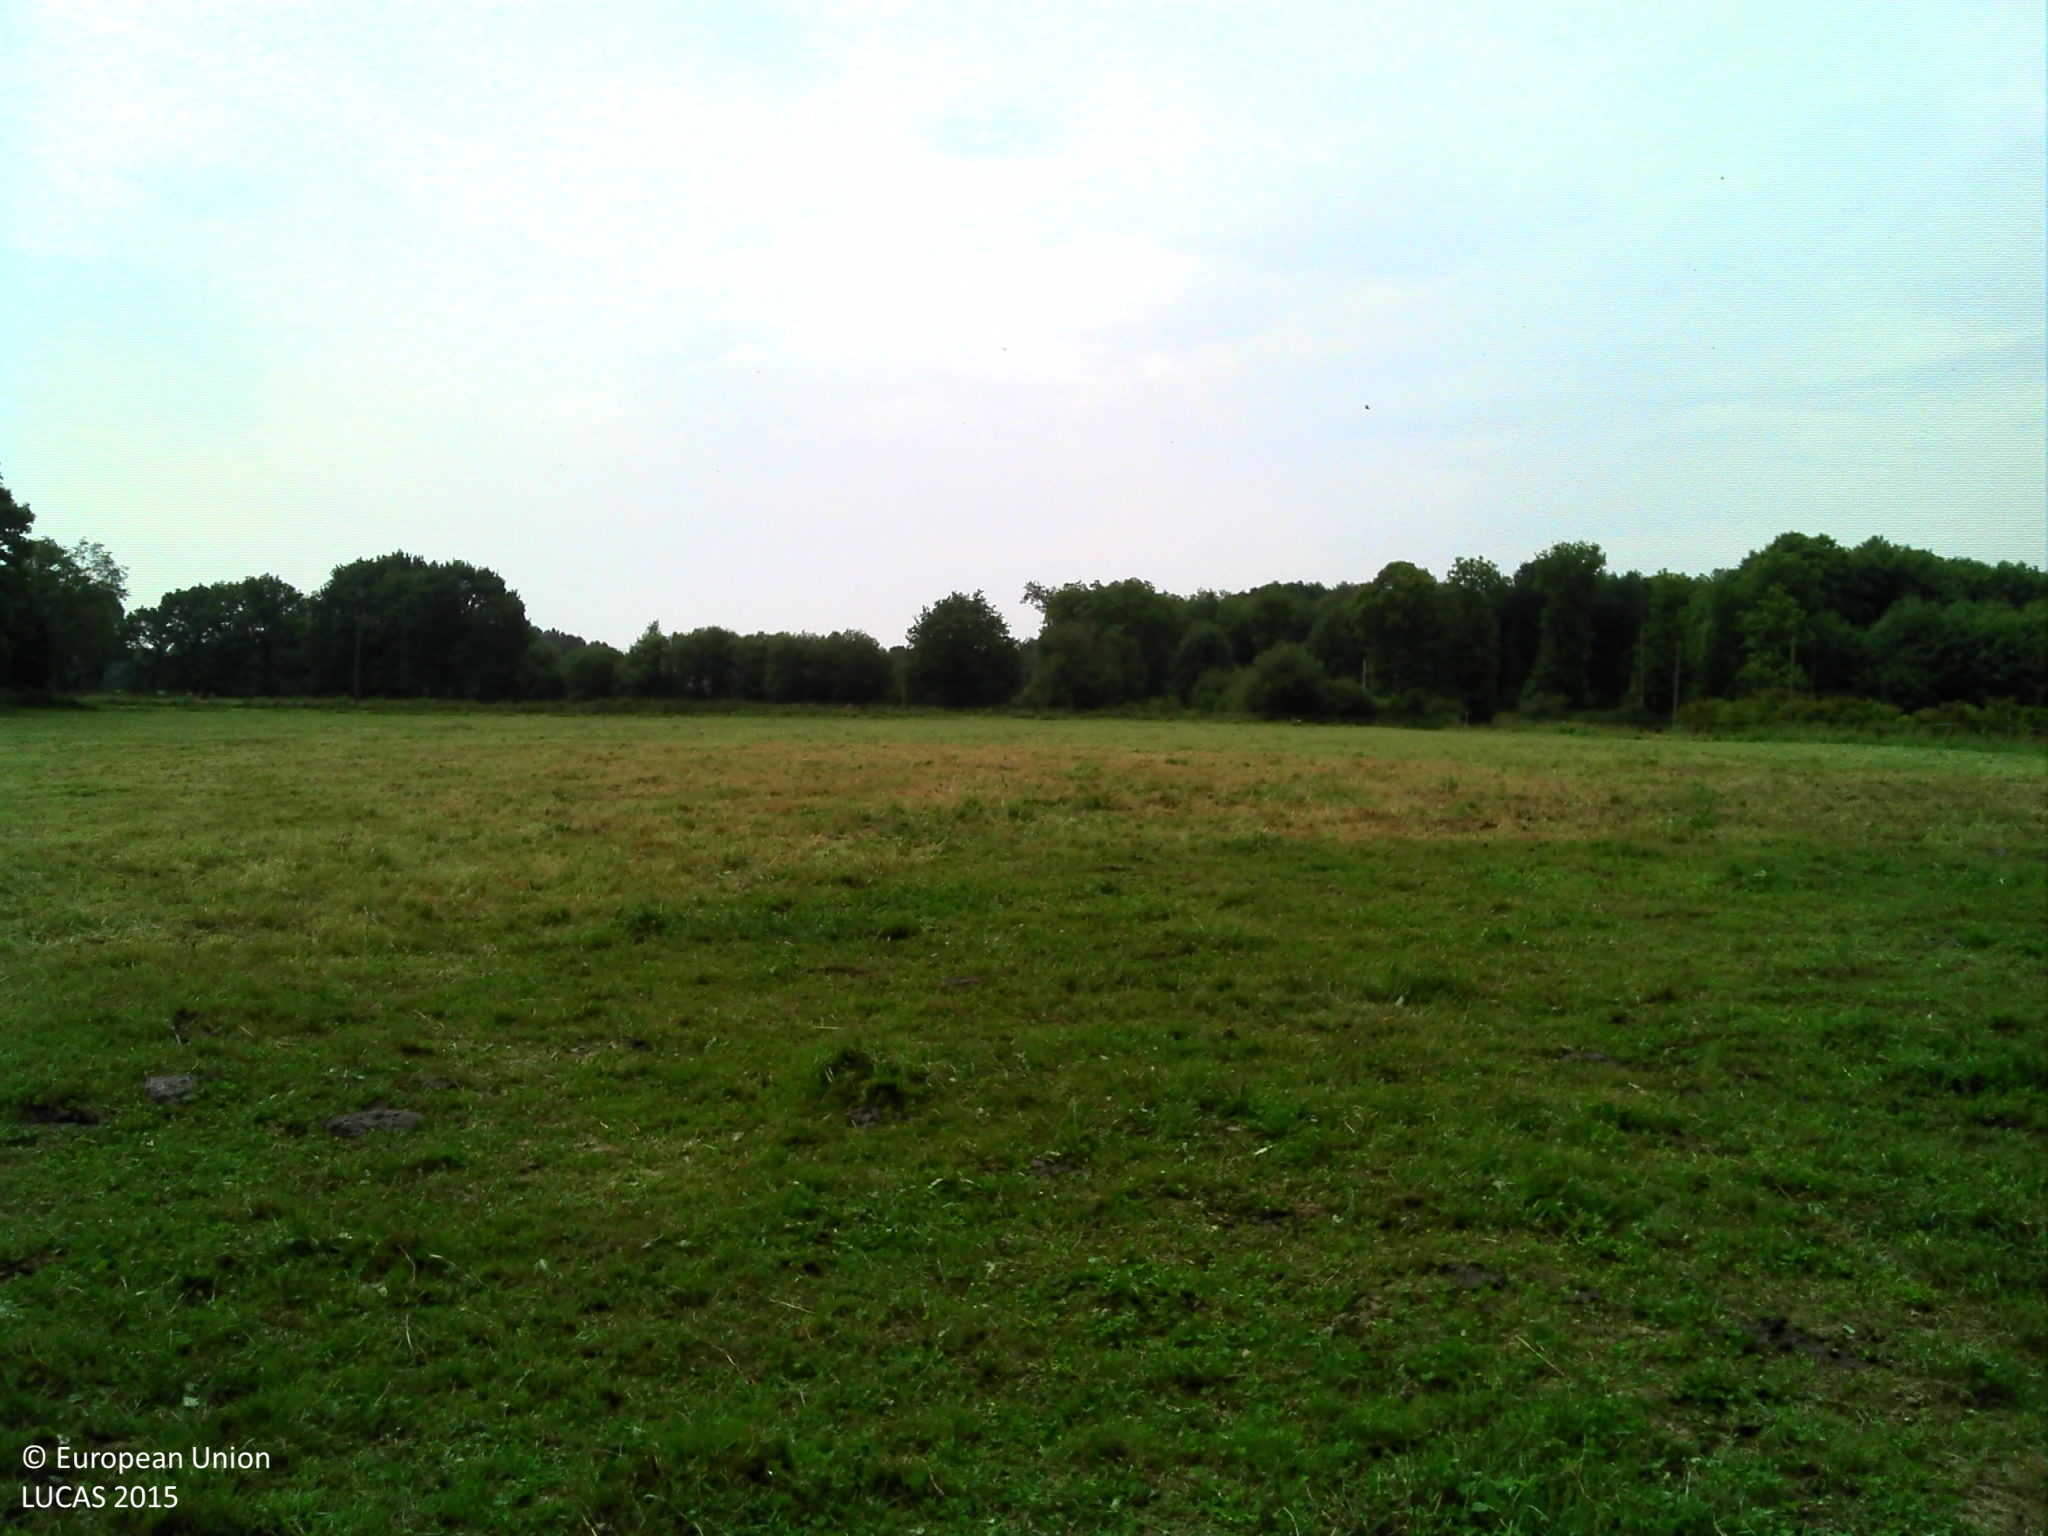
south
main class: Grassland
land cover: Grassland without tree/shrub cover
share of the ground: > 75 %
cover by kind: herbaceous plants 100 %
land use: Agriculture (excluding fallow land and kitchen gardens)
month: June
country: FR
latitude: 48.1503
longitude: -2.1387
